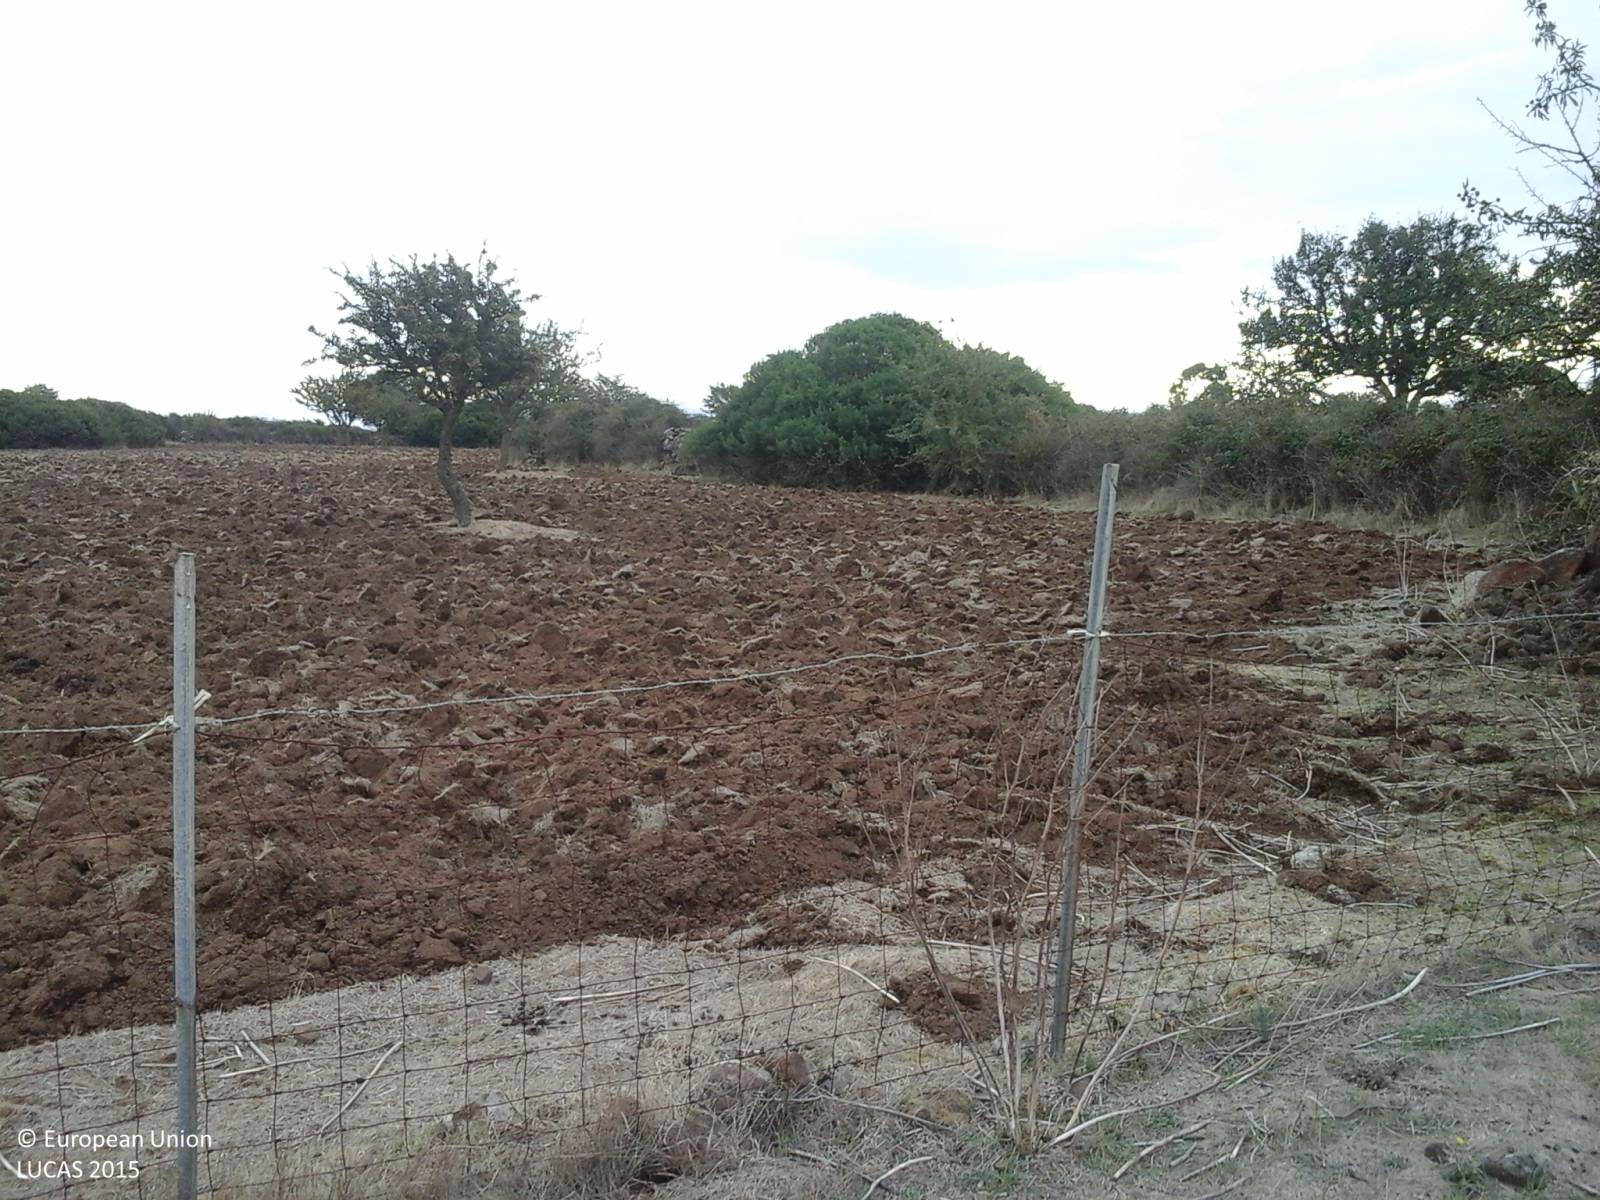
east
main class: Grassland
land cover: Grassland without tree/shrub cover
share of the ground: 50 - 75 %
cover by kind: herbaceous plants 100 %
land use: Agriculture (excluding fallow land and kitchen gardens)
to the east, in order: Grassland without tree/shrub cover; Fences; Other bare soil; Abandoned hedges; Grassland with sparse tree/shrub cover; Abandoned hedges
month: September
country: IT
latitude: 40.1886
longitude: 8.8901
